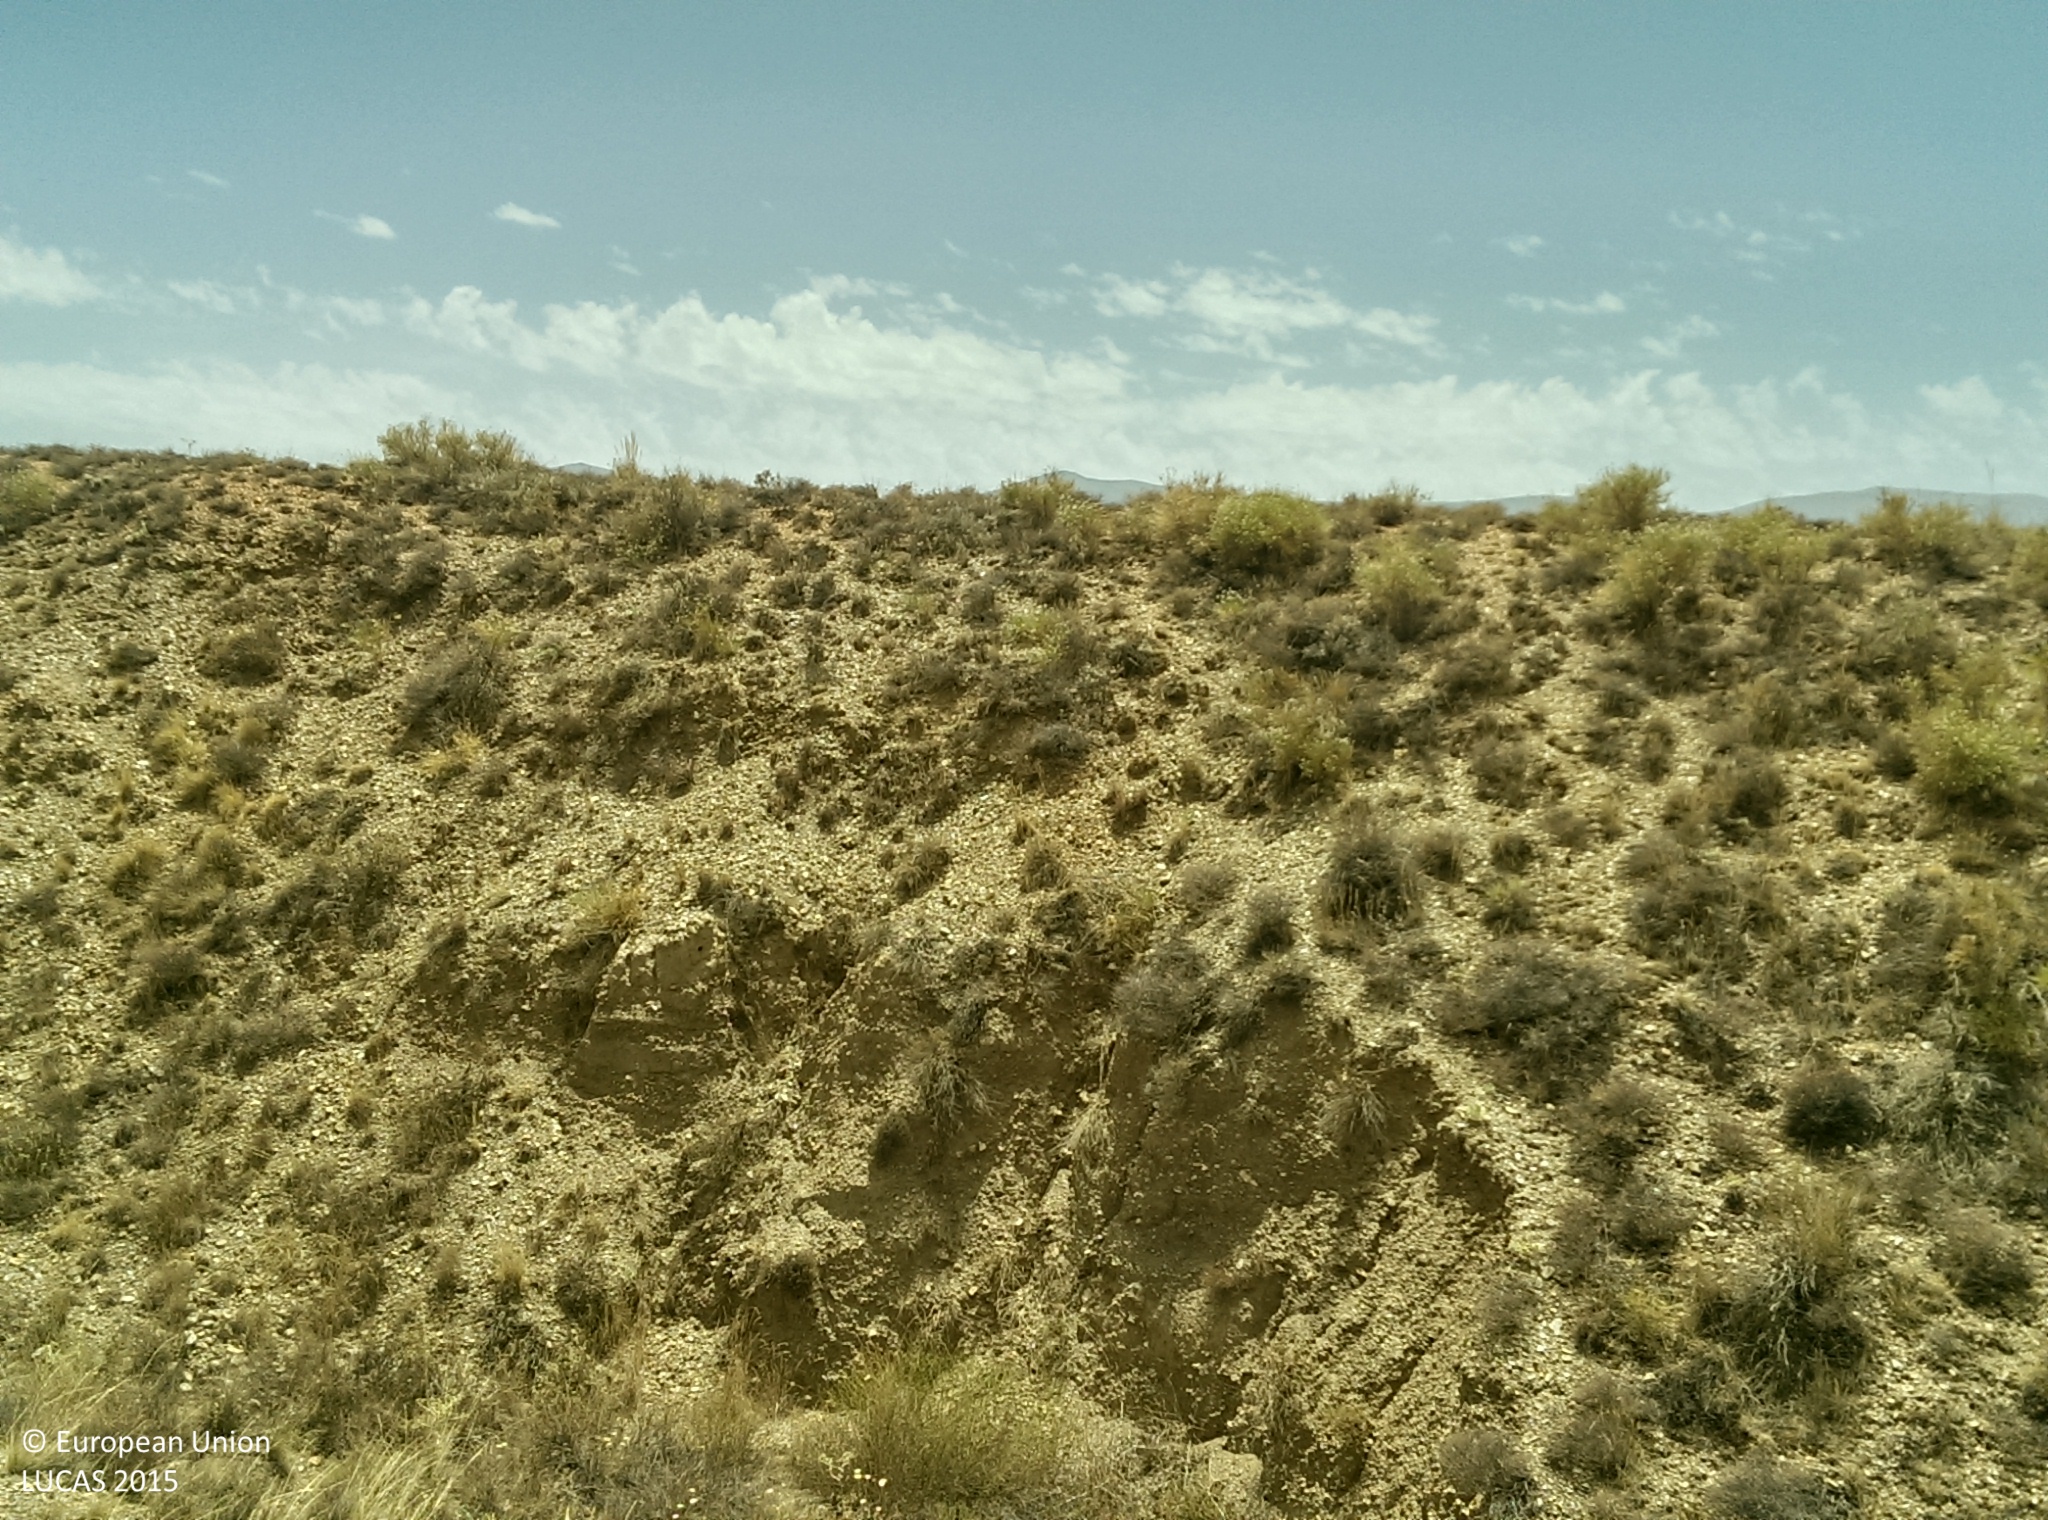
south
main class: Shrubland
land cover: Shrubland without tree cover
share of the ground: 25 - 50 %
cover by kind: shrubs 45 %, unconsolidated bare surface 35 %, herbaceous plants 20 %
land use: Semi-natural and natural areas not in use
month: July
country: ES
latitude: 37.2234
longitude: -3.0926
